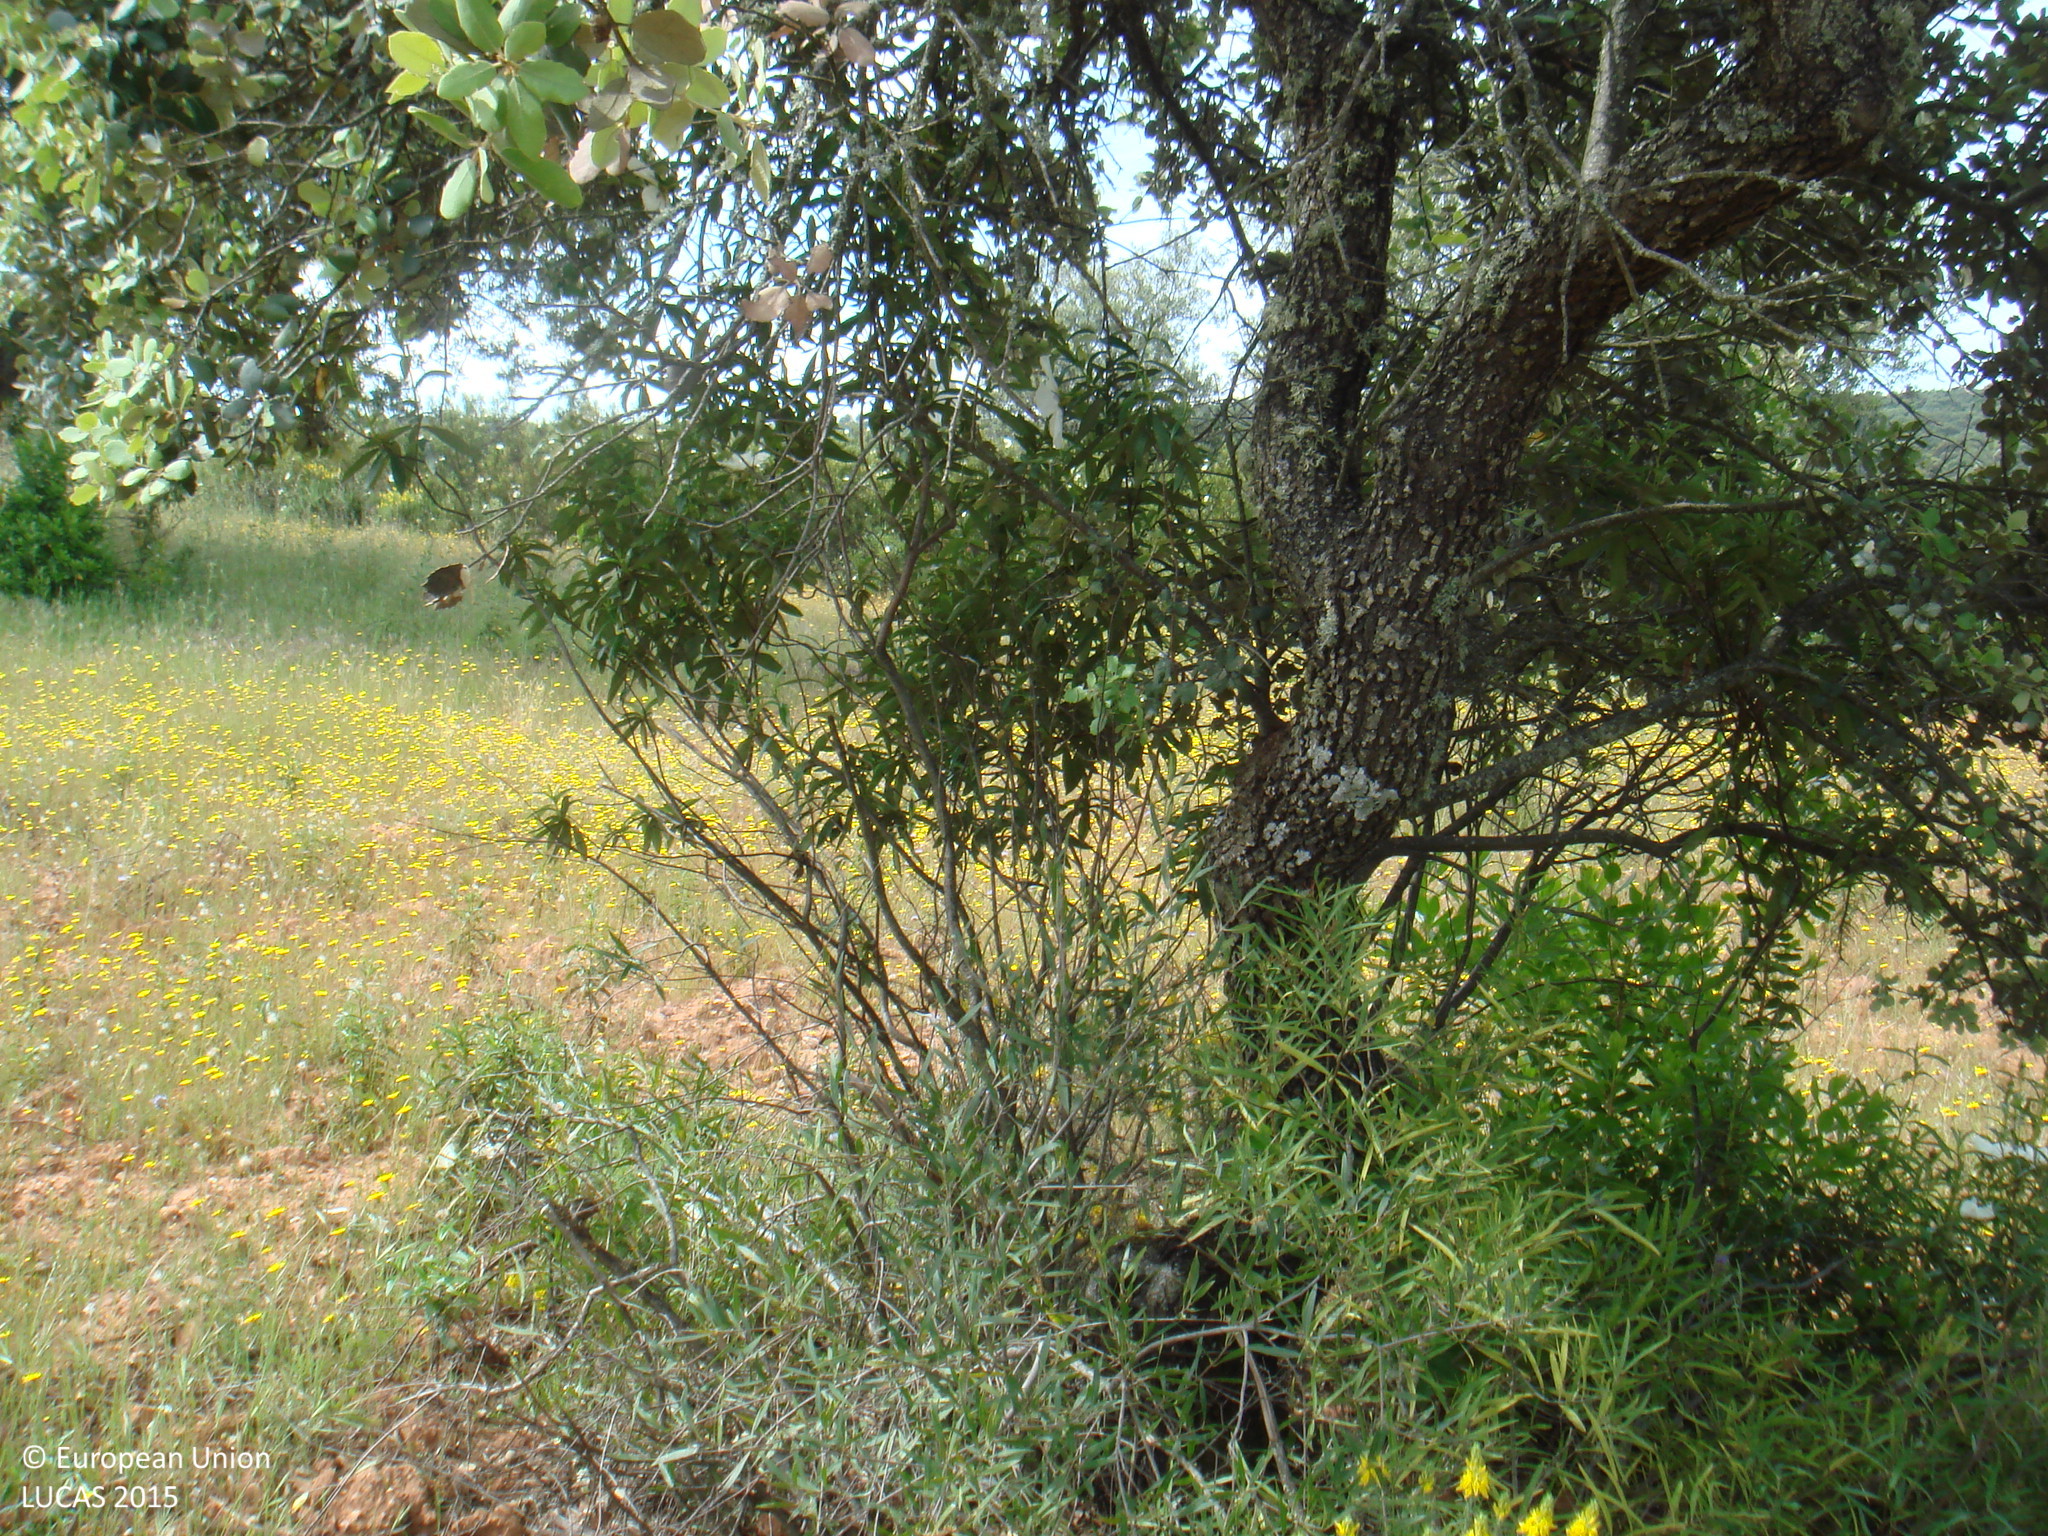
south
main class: Woodland
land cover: Broadleaved woodland
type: broadleaved evergreen forest
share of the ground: 25 - 50 %
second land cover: Shrubland without tree cover
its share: 25 - 50 %
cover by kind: herbaceous plants 50 %, shrubs 30 %, broadleaved forest trees 20 %
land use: Forestry
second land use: Agriculture (excluding fallow land and kitchen gardens)
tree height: > 5 m
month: May
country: ES
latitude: 38.3526
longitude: -5.1204
